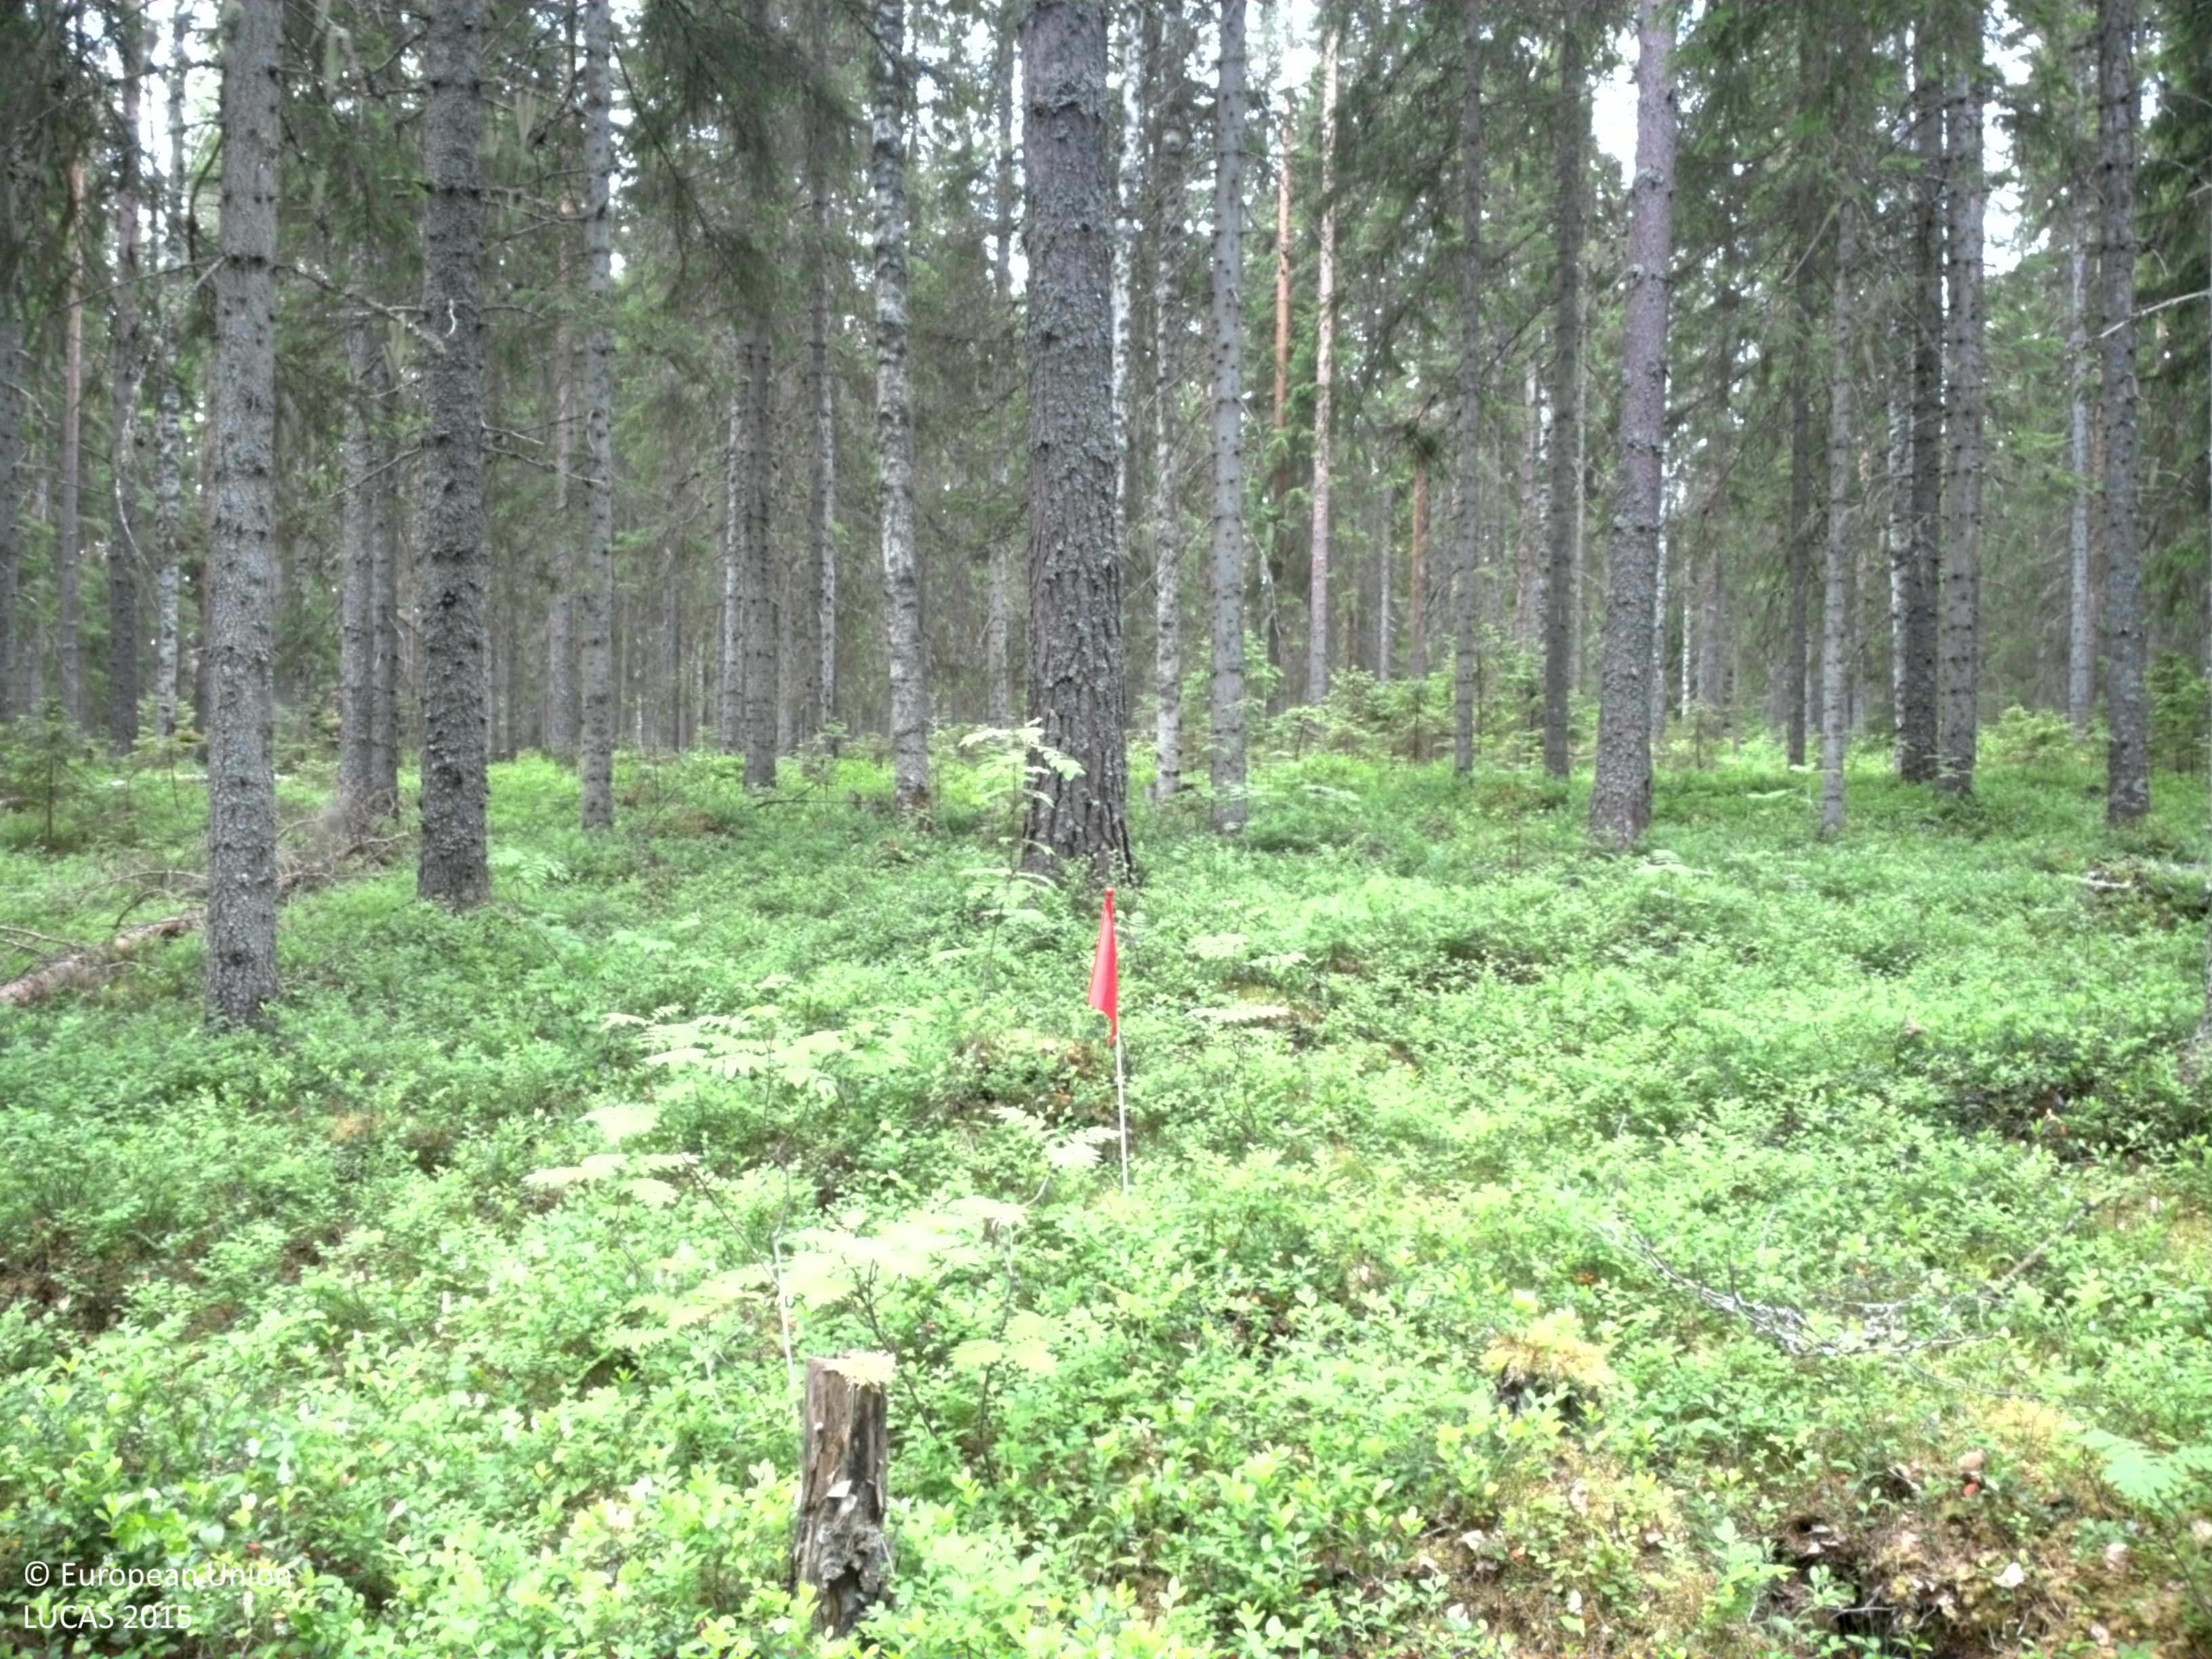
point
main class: Woodland
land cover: Spruce dominated coniferous woodland
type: boreal forest
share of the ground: 50 - 75 %
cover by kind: coniferous forest trees 75 %, shrubs 25 %
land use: Forestry
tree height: > 5 m
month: July
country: SE
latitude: 64.4606
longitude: 20.8944
